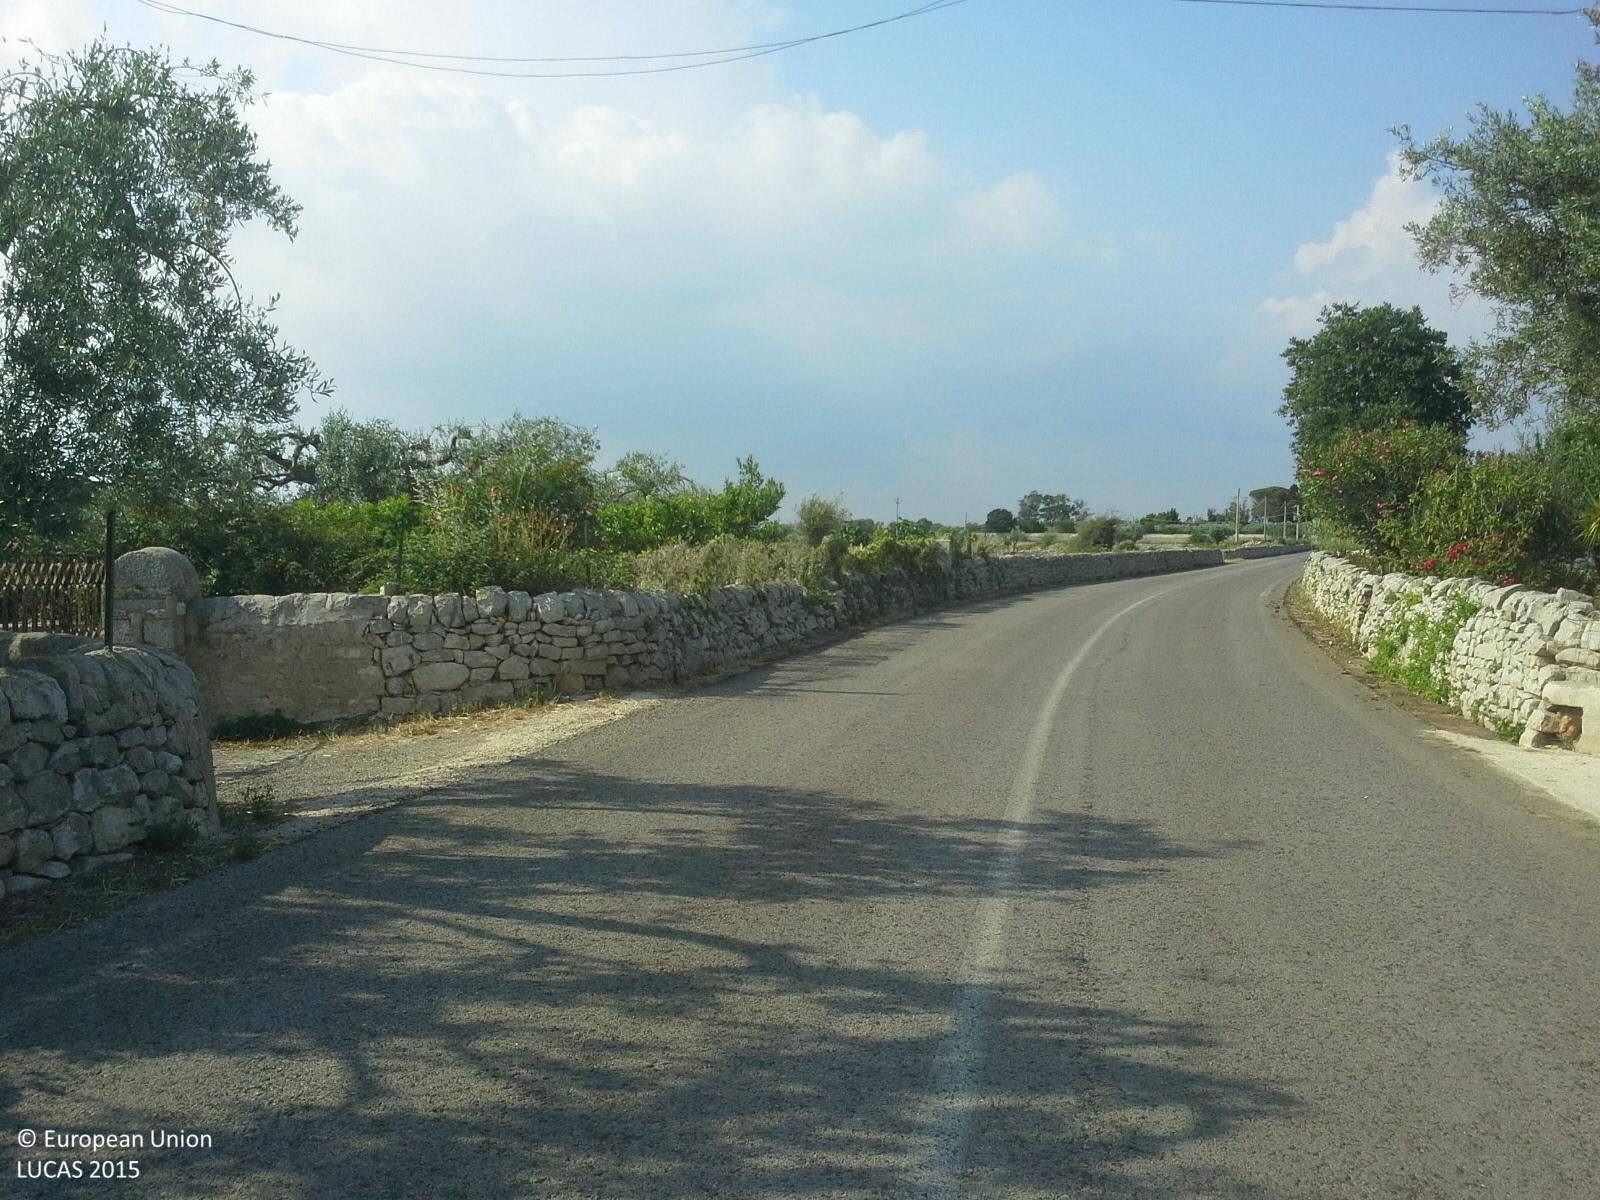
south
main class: Cropland
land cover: Durum wheat
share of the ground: > 75 %
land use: Agriculture (excluding fallow land and kitchen gardens)
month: June
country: IT
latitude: 36.8591
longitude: 14.8628
